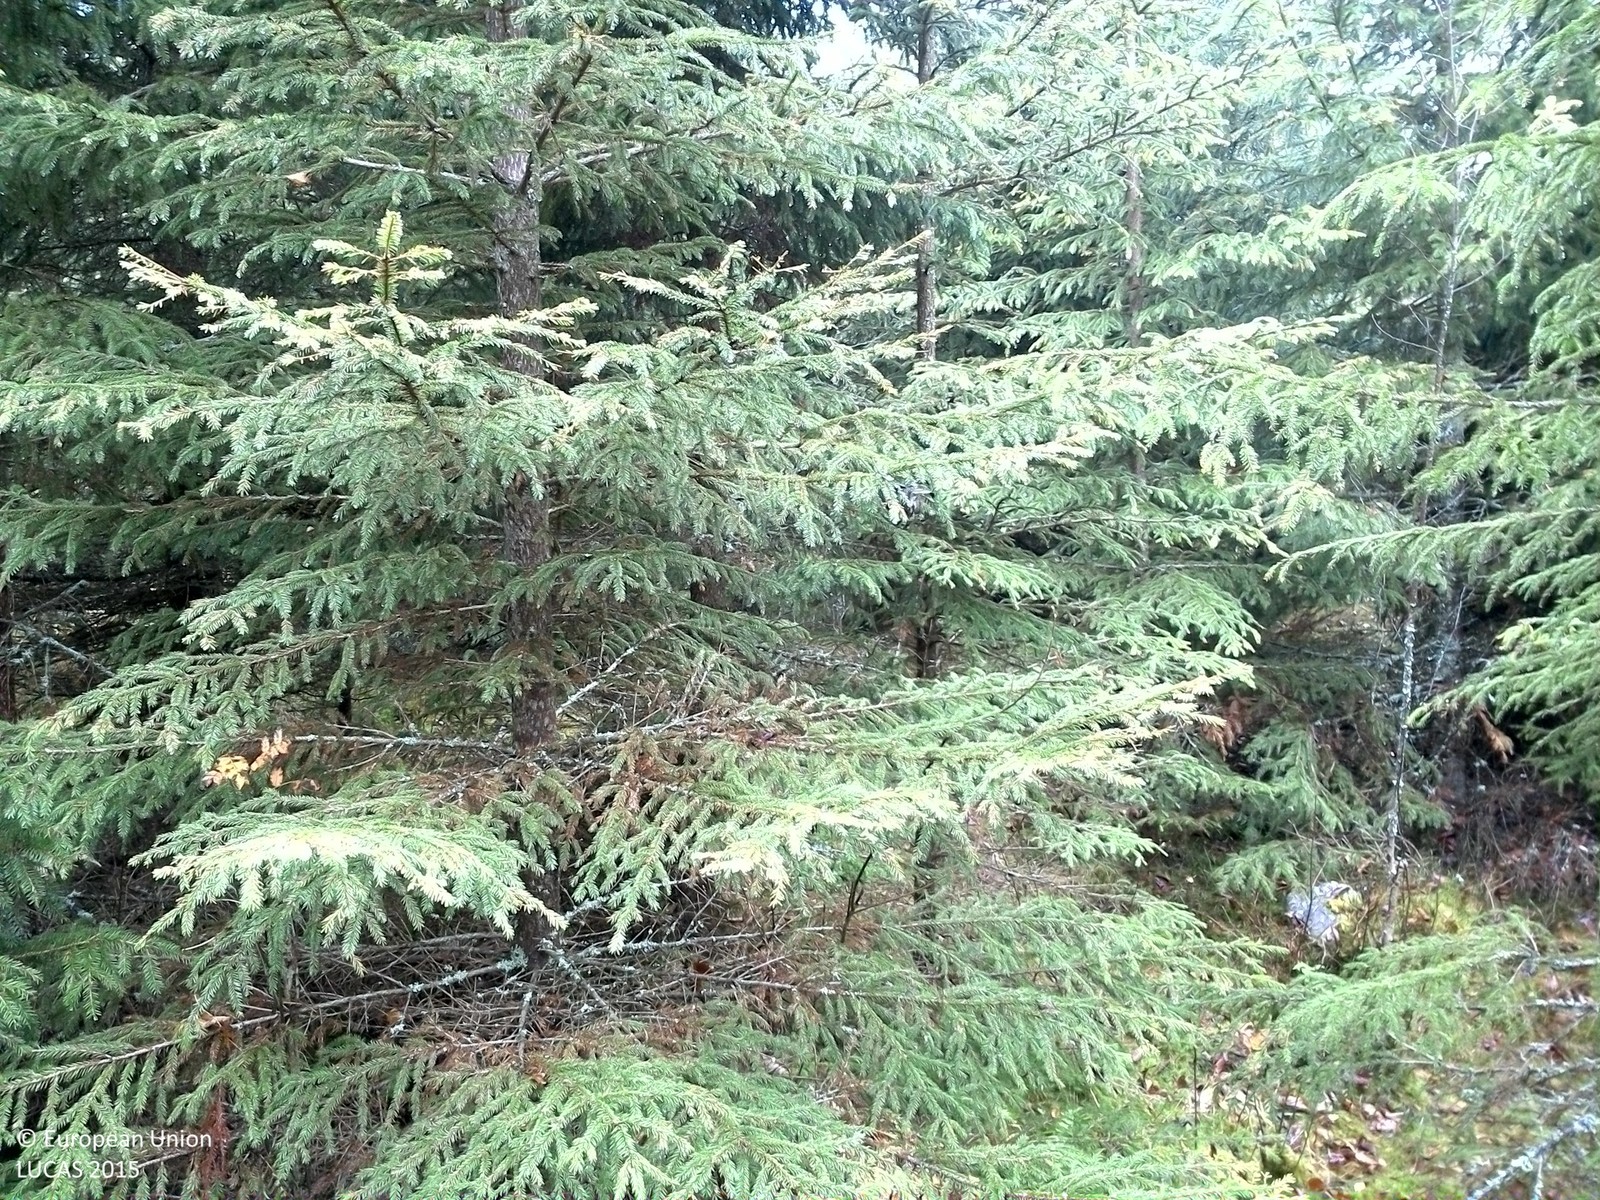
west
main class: Woodland
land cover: Spruce dominated coniferous woodland
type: boreal forest
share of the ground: > 75 %
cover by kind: coniferous forest trees 75 %, lichens and mosses 10 %, broadleaved forest trees 5 %, shrubs 5 %, herbaceous plants 5 %
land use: Forestry
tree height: < 5 m
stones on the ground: 10 - 25 %
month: November
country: SE
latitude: 57.8562
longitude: 15.0002
